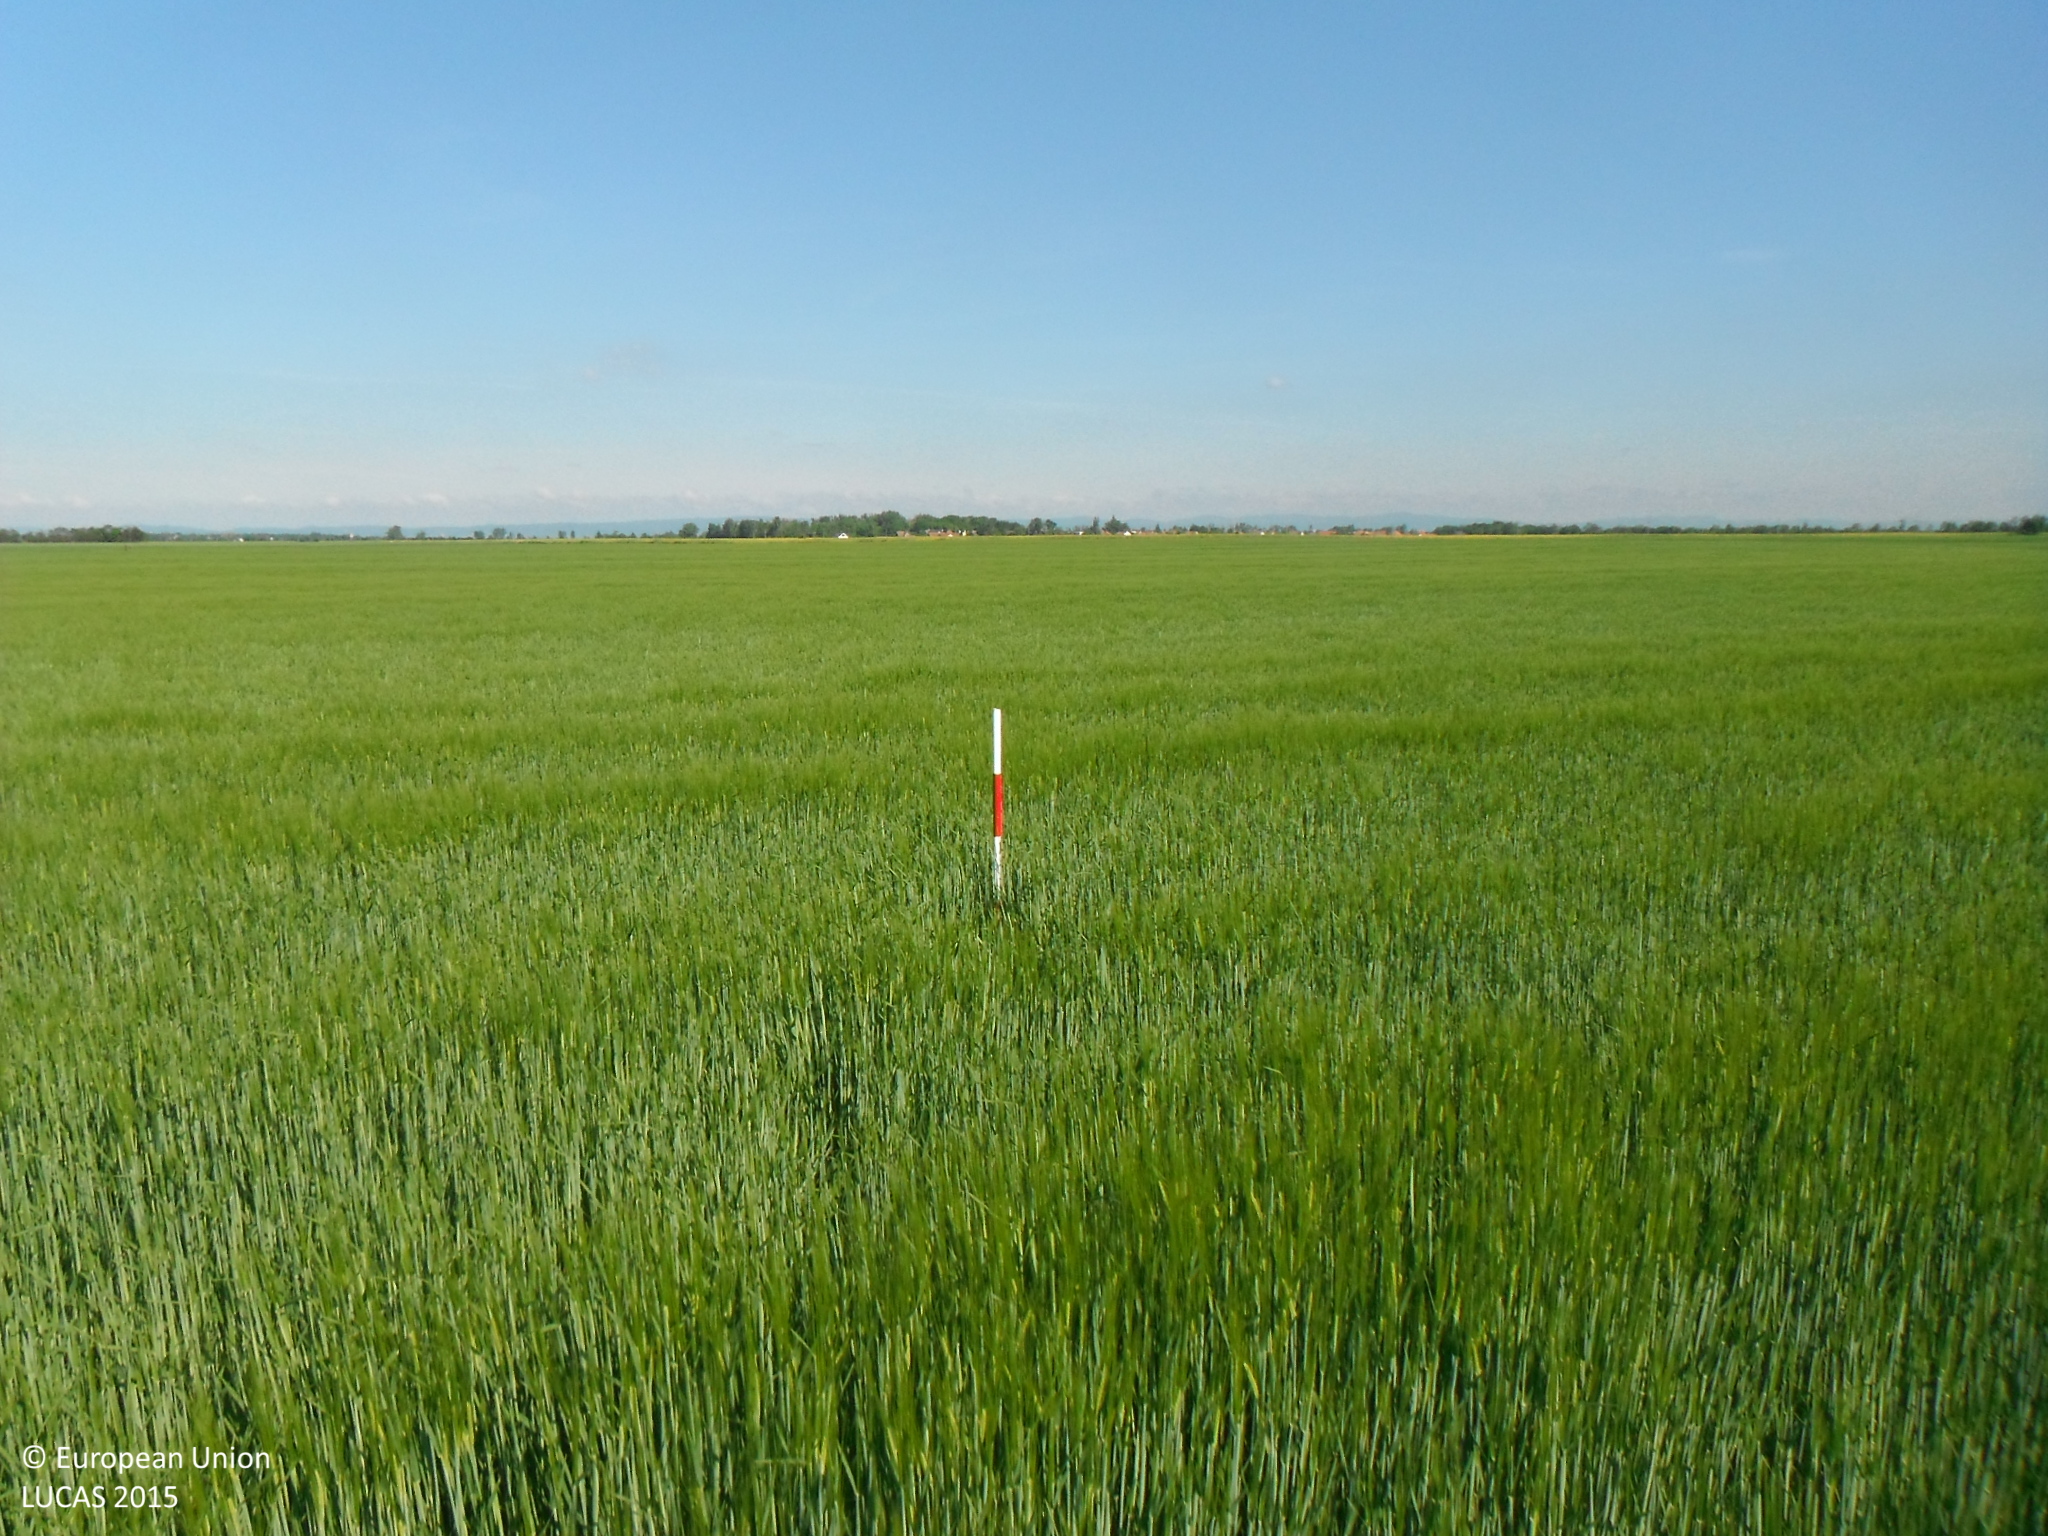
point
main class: Cropland
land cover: Barley
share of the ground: > 75 %
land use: Agriculture (excluding fallow land and kitchen gardens)
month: May
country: SK
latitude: 48.0791
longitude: 17.4593
